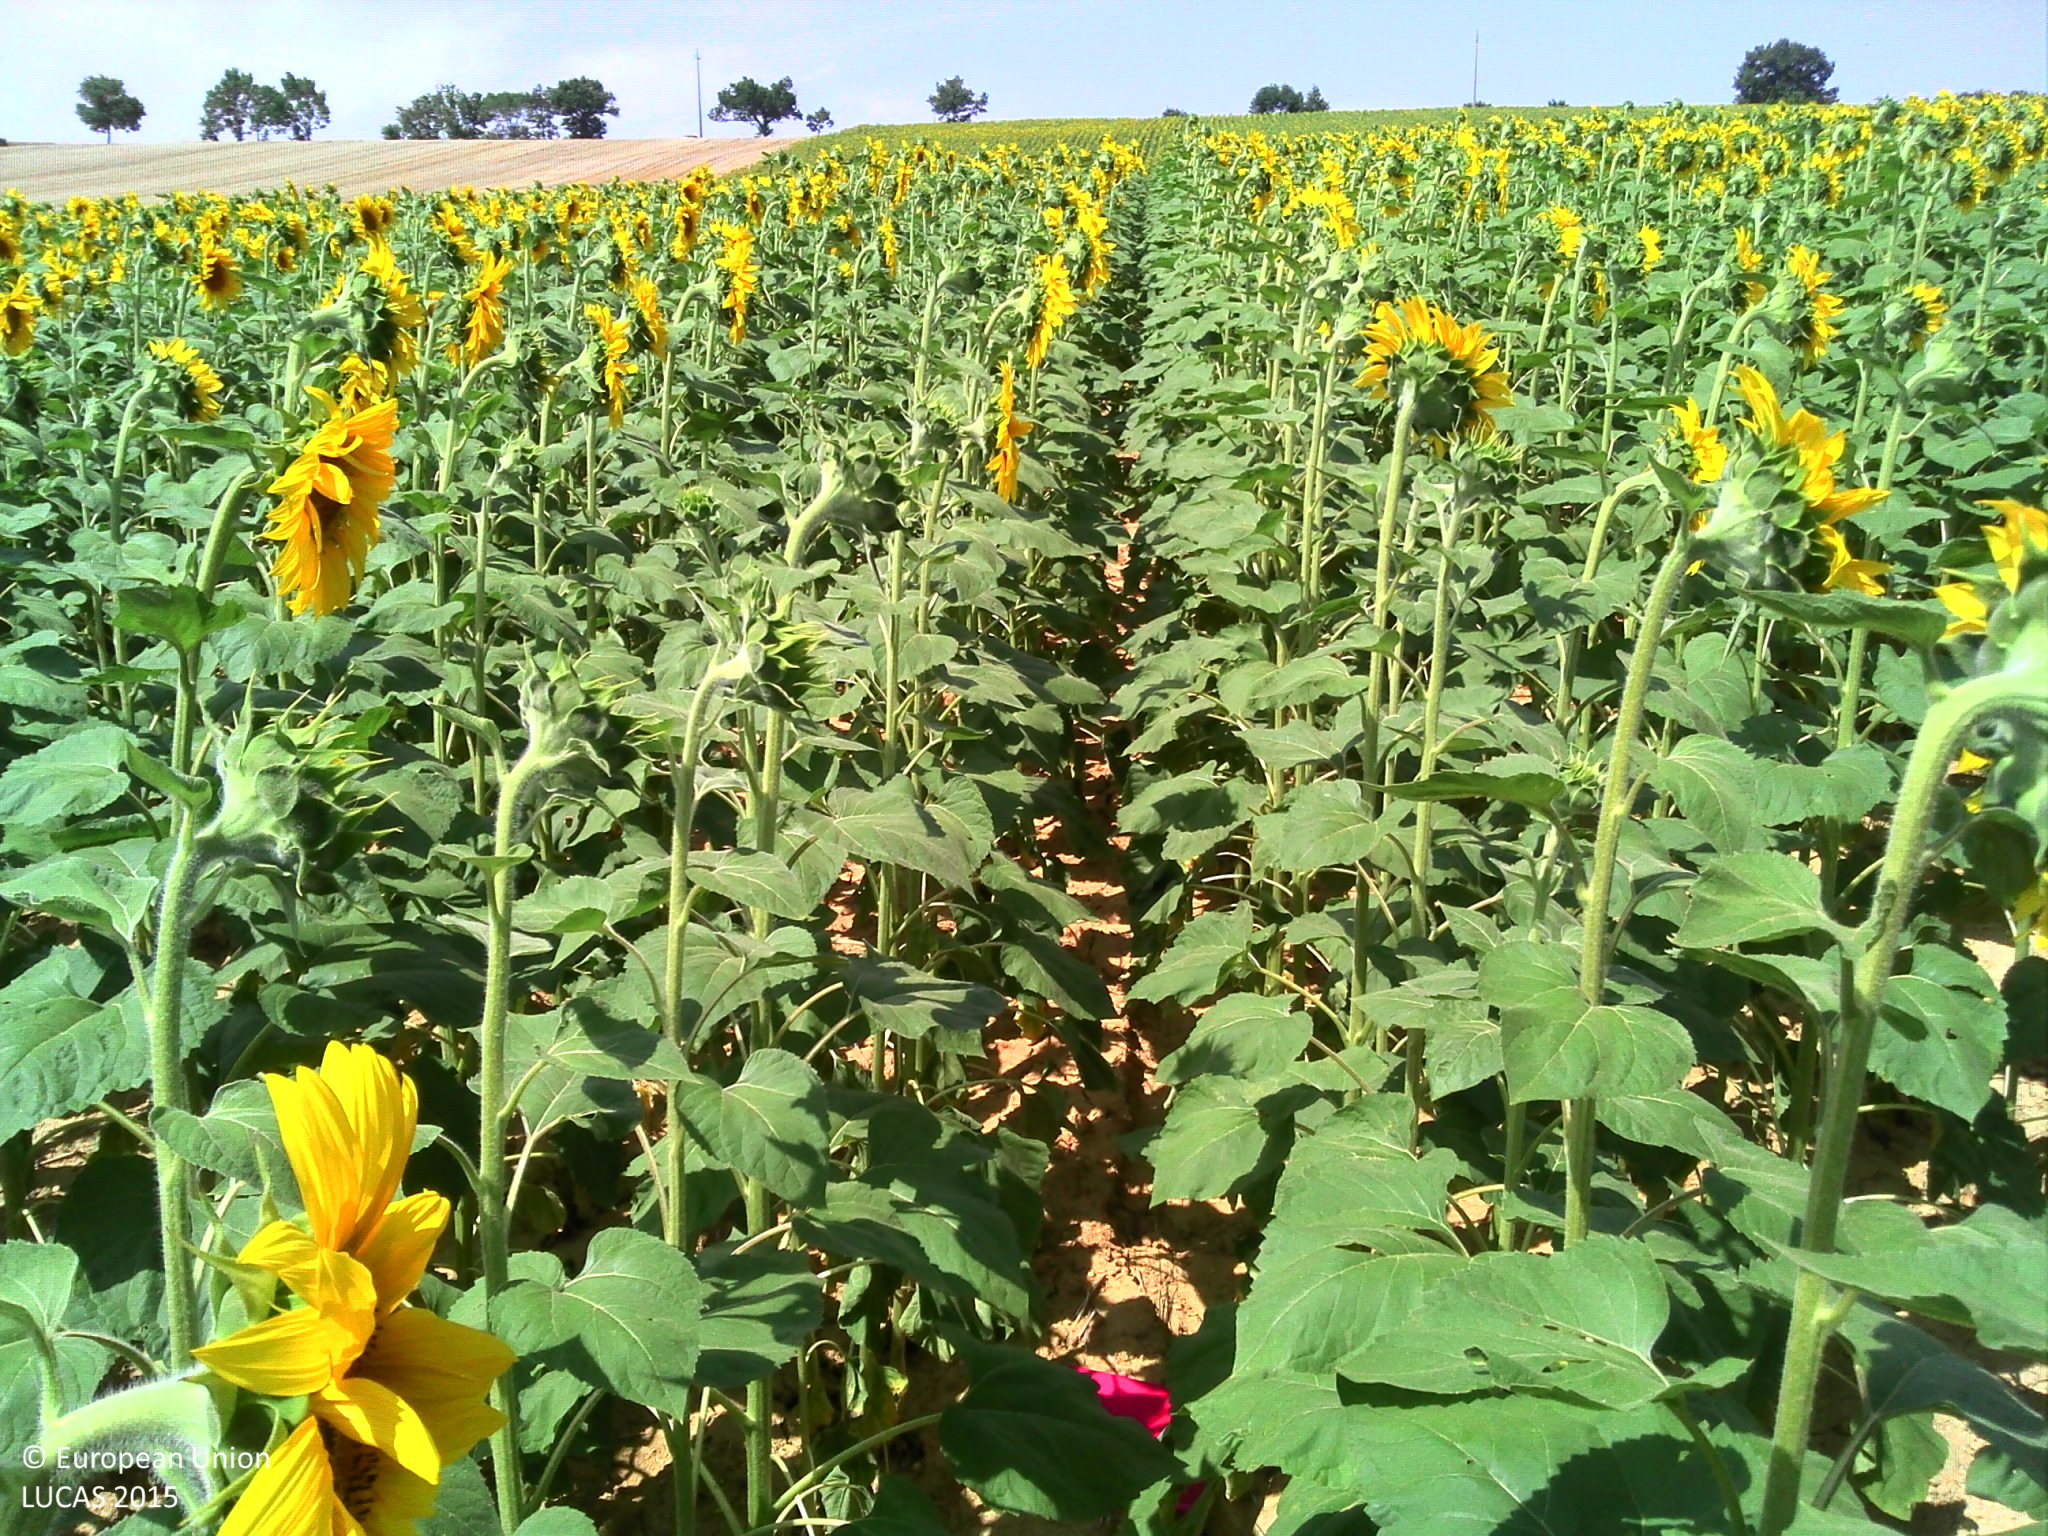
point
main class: Cropland
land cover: Sunflower
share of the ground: > 75 %
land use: Agriculture (excluding fallow land and kitchen gardens)
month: July
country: FR
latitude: 43.5375
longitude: 0.9543
